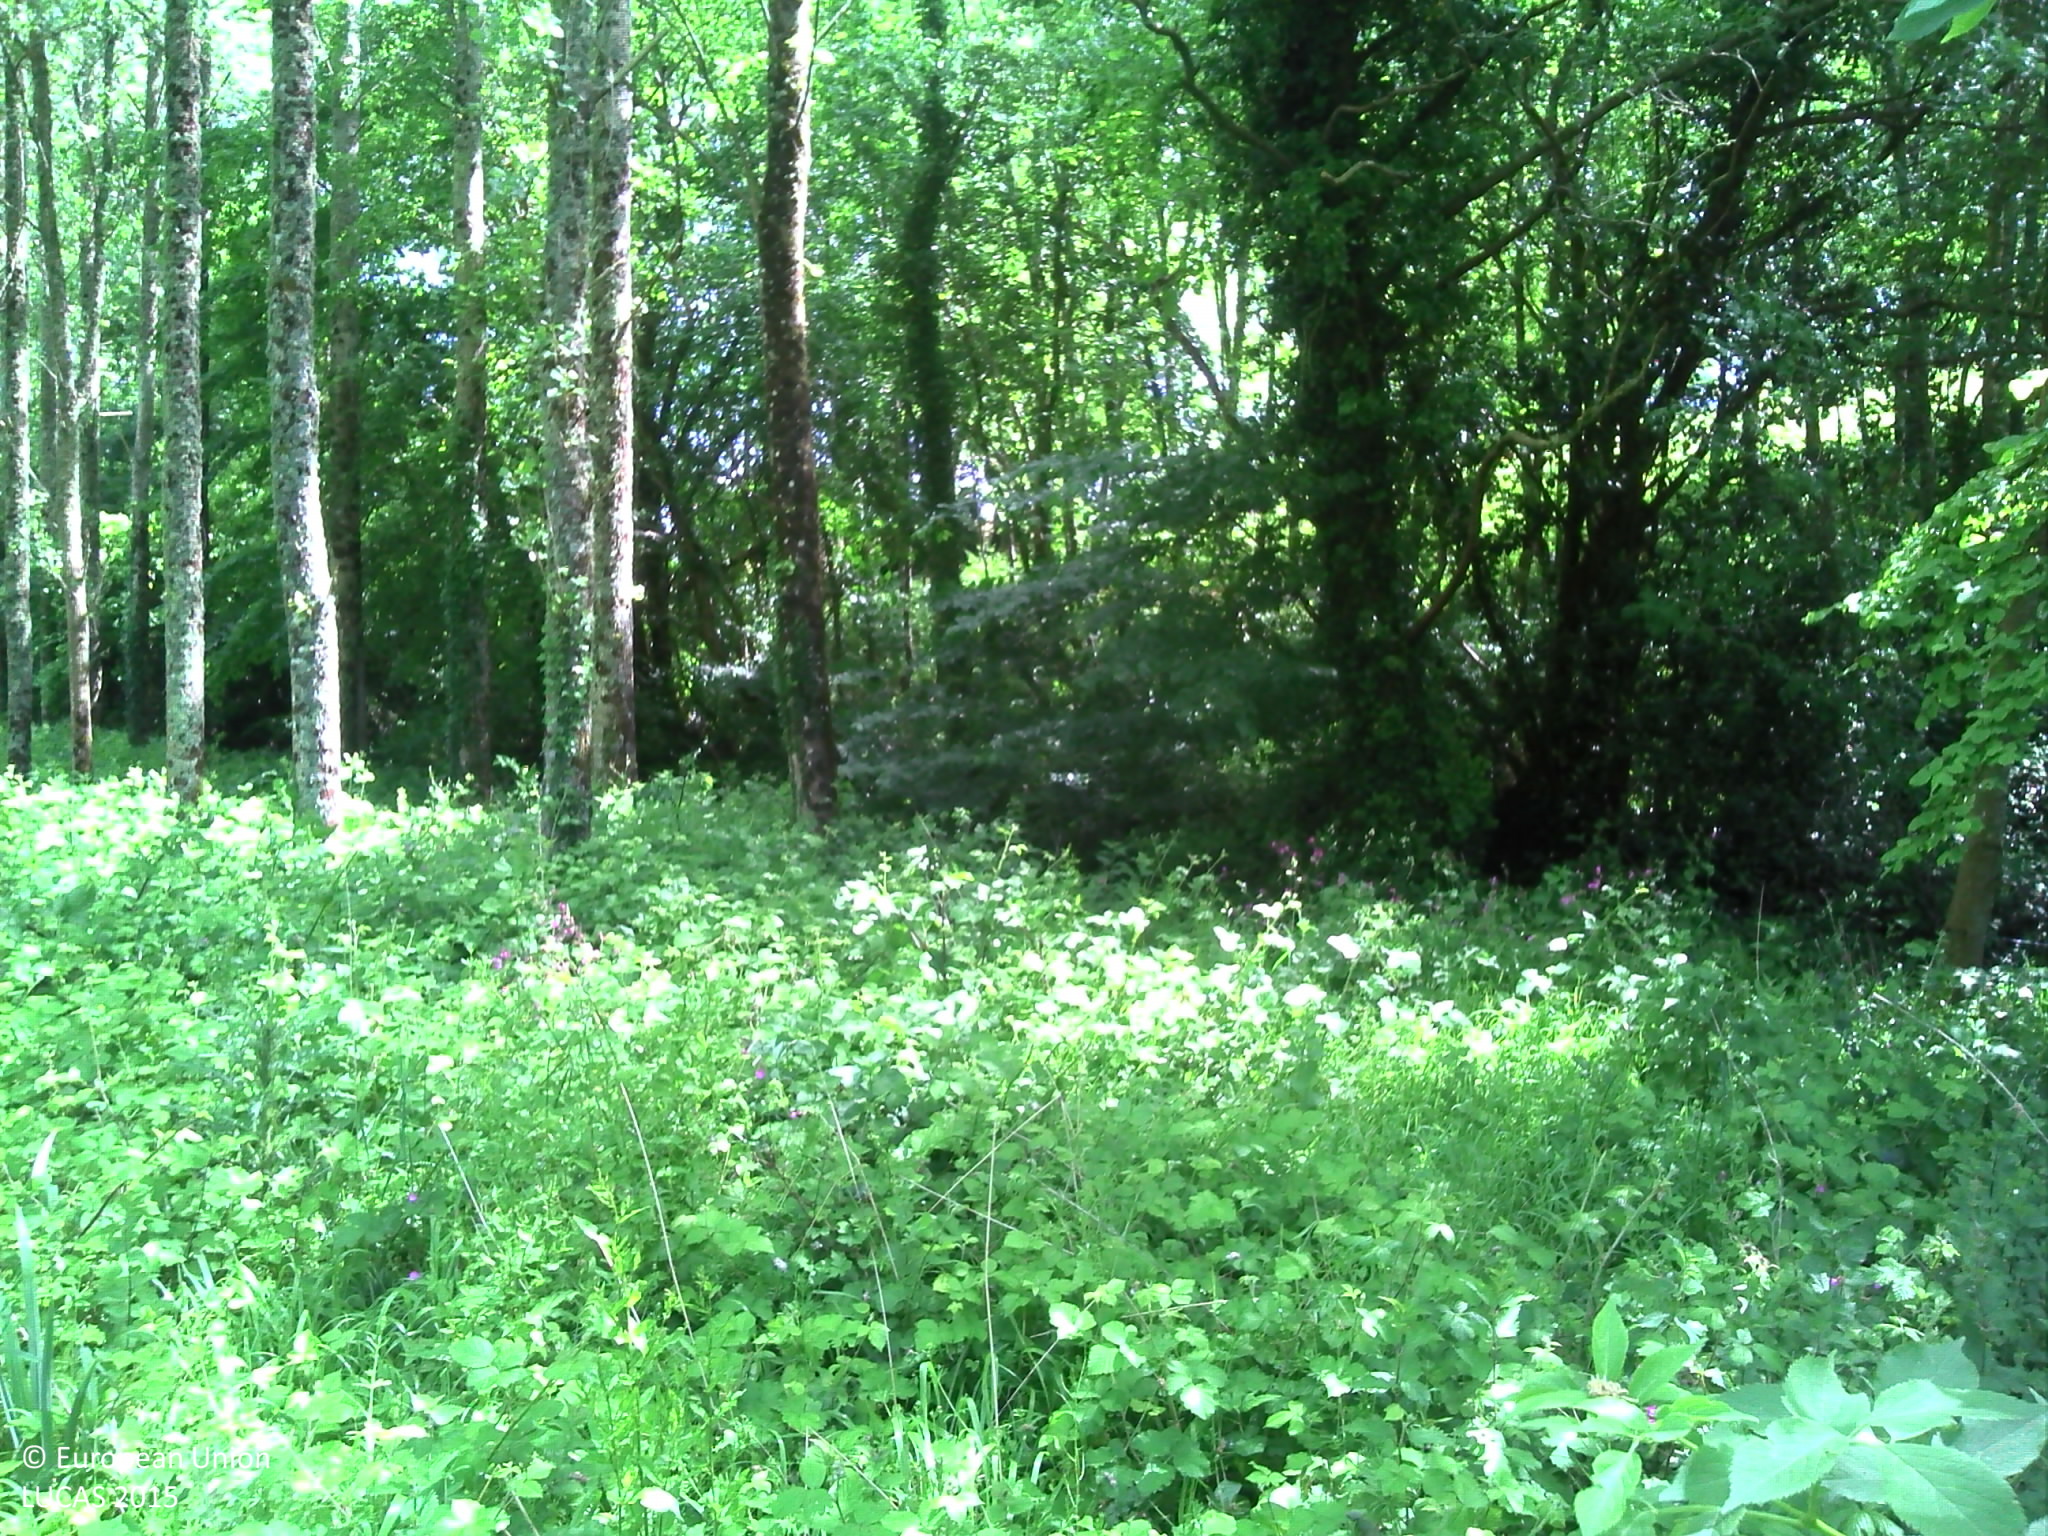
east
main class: Woodland
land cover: Broadleaved woodland
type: exotic forest
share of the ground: > 75 %
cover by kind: broadleaved forest trees 70 %, herbaceous plants 30 %
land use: Forestry
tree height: > 5 m
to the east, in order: Fences; Broadleaved woodland; Rivers and streams; Broadleaved woodland; Tracks; Broadleaved woodland; Spontaneously vegetated surfaces; Broadleaved woodland; Grassland without tree/shrub cover; Abandoned hedges; Maize
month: June
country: FR
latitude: 49.4365
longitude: -1.6768
